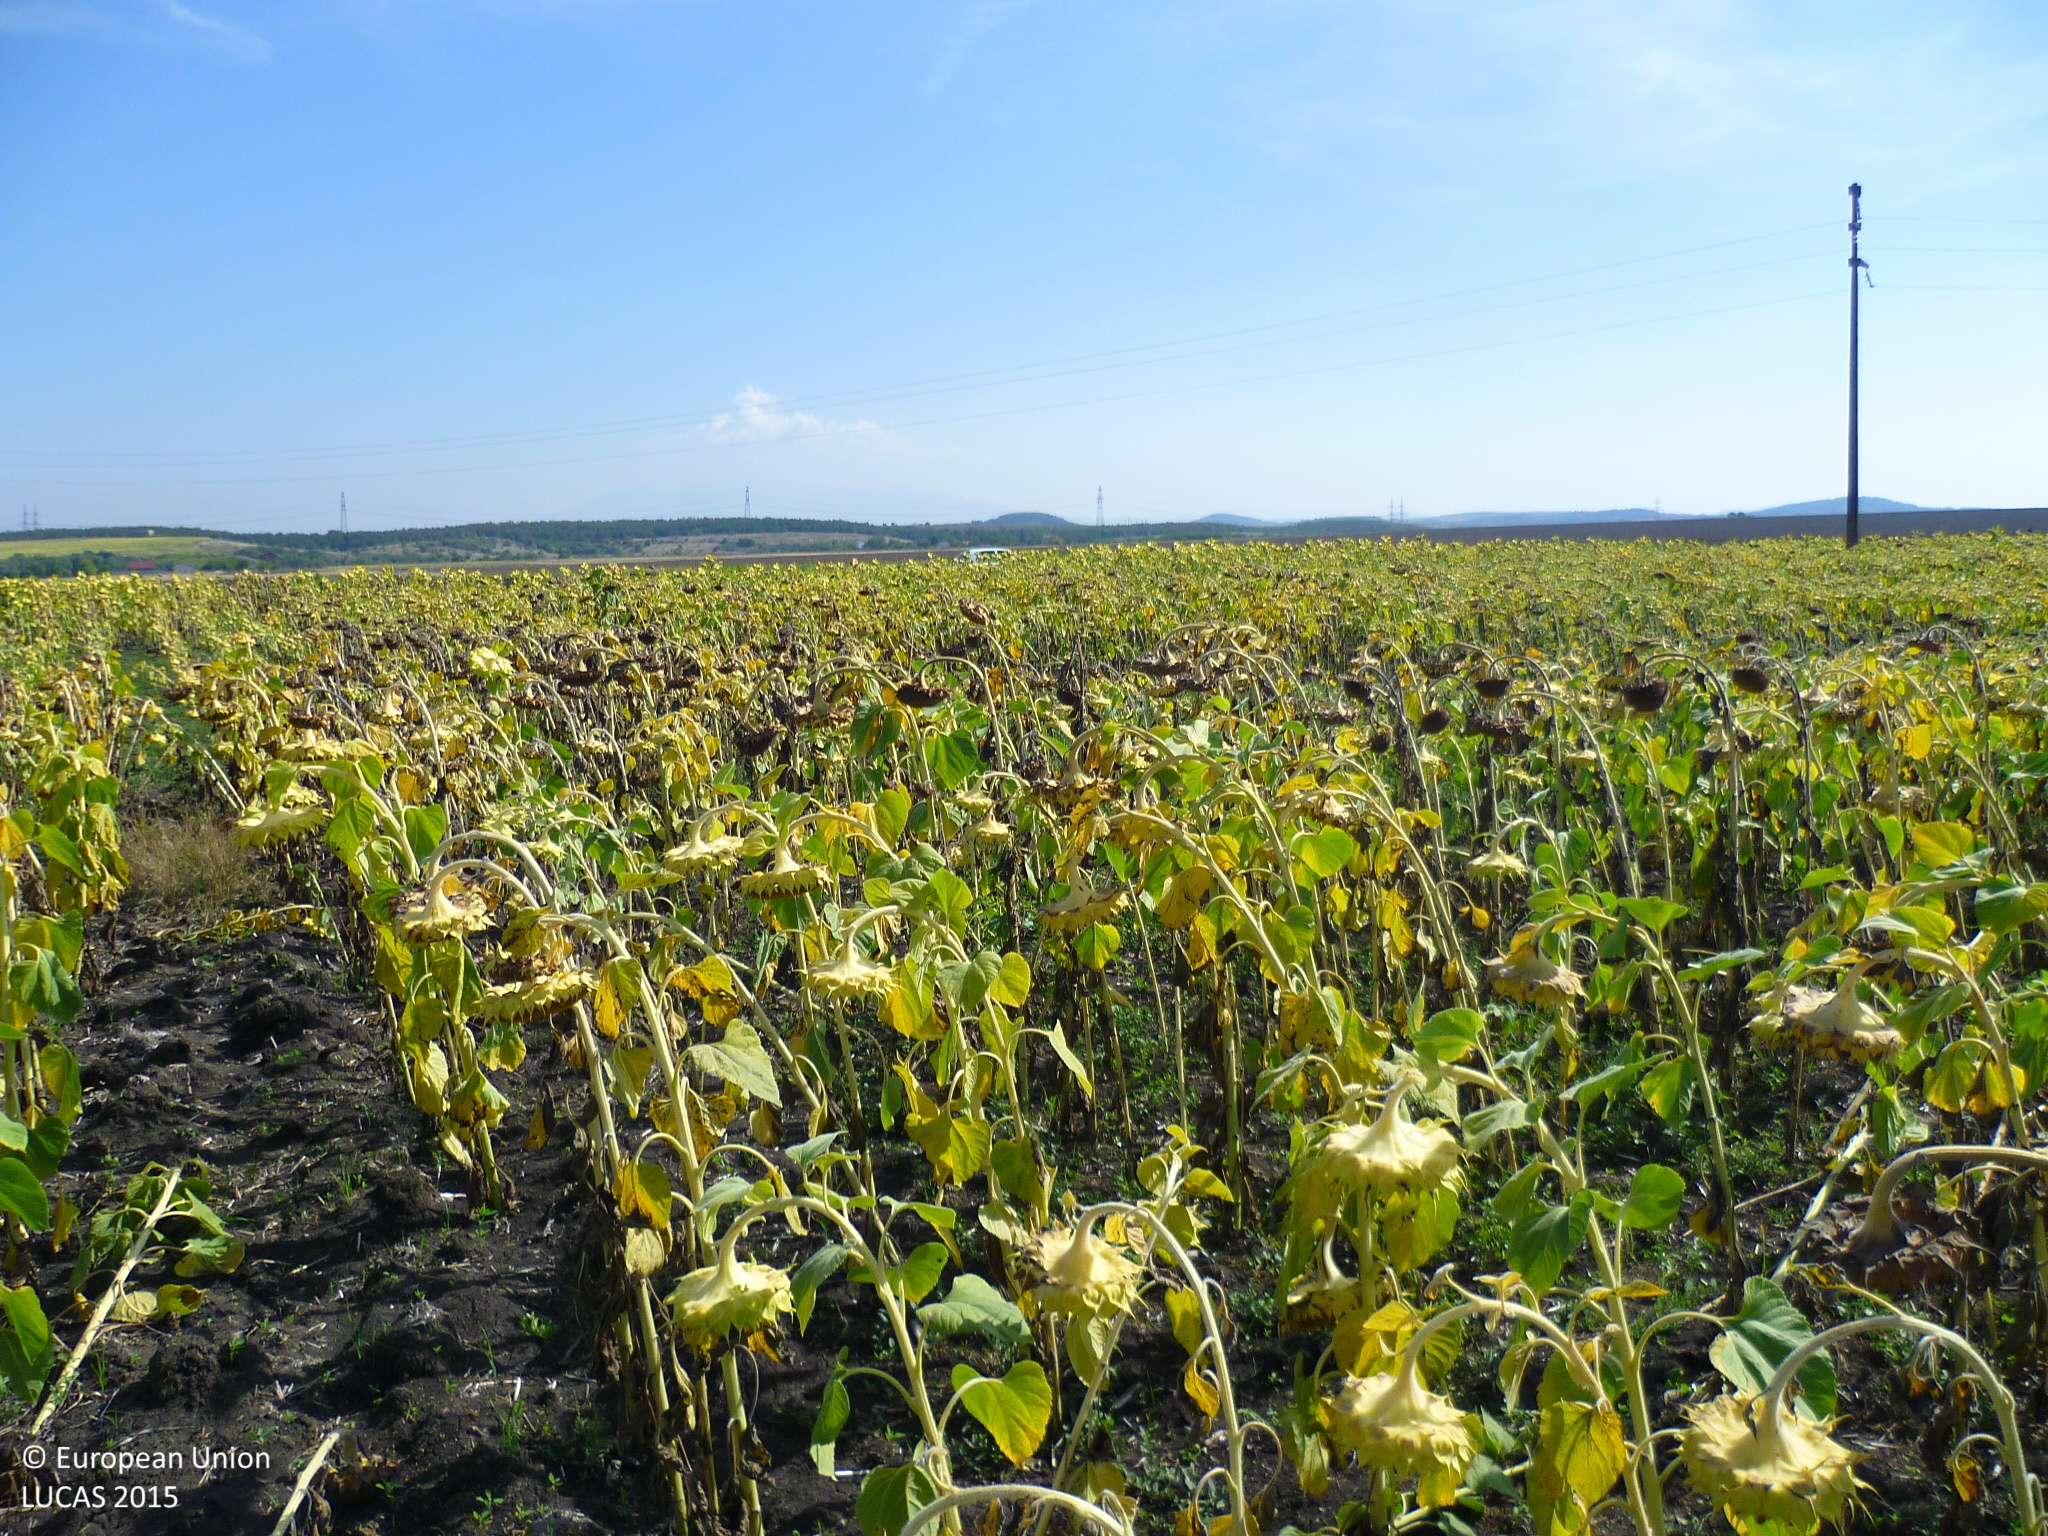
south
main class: Cropland
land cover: Sunflower
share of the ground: > 75 %
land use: Agriculture (excluding fallow land and kitchen gardens)
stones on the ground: < 10 %
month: December
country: BG
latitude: 42.8243
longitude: 23.0836
